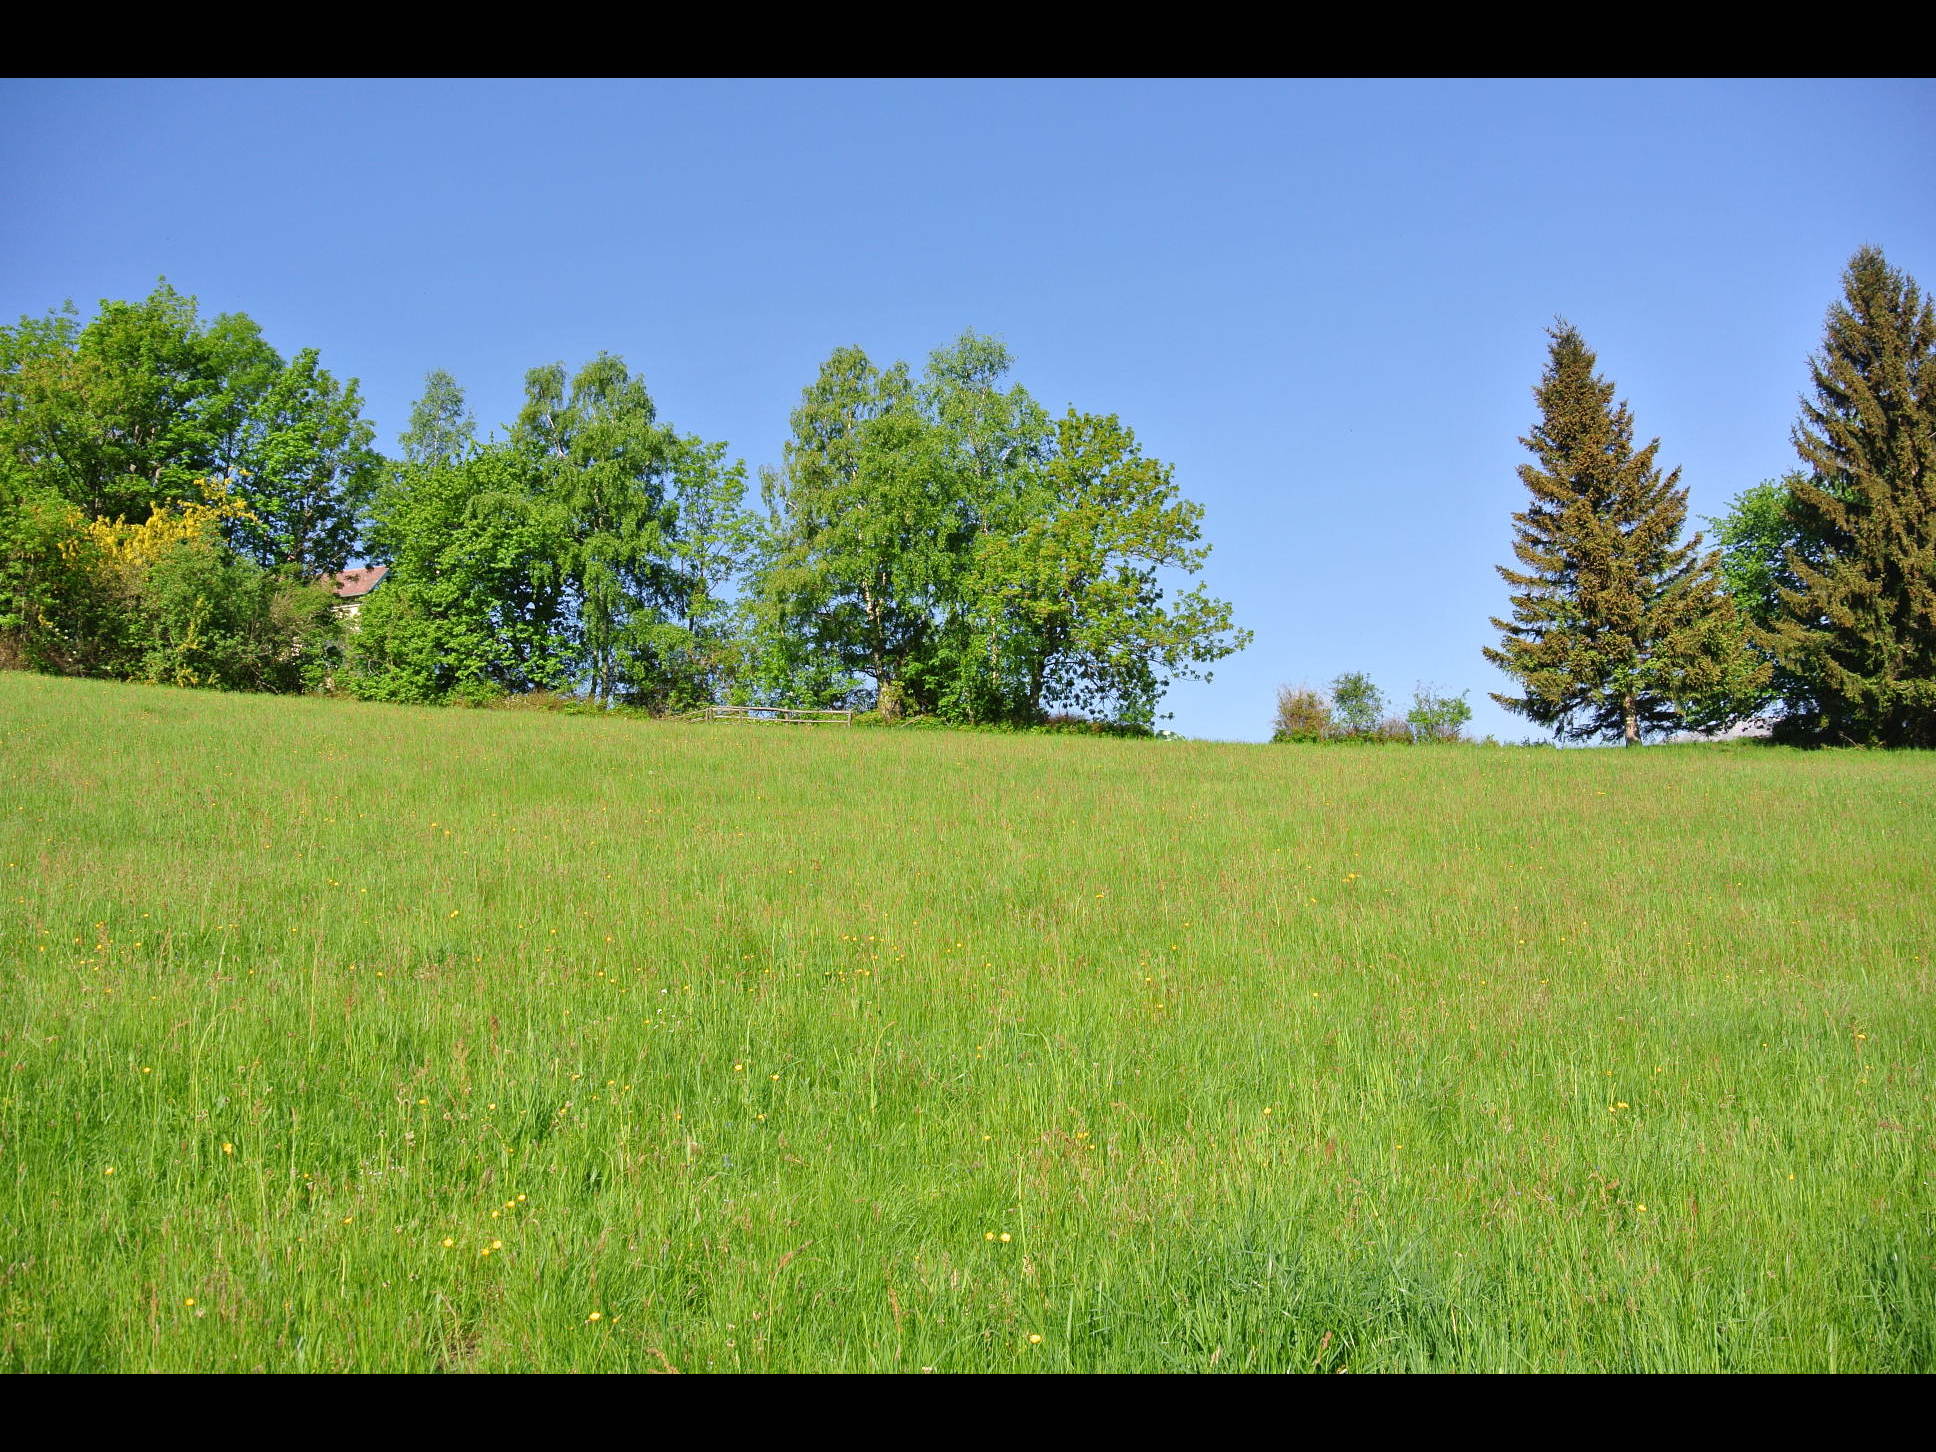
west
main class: Grassland
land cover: Grassland without tree/shrub cover
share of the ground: > 75 %
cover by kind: herbaceous plants 100 %
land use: Agriculture (excluding fallow land and kitchen gardens)
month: May
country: AT
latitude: 47.6741
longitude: 15.7959
